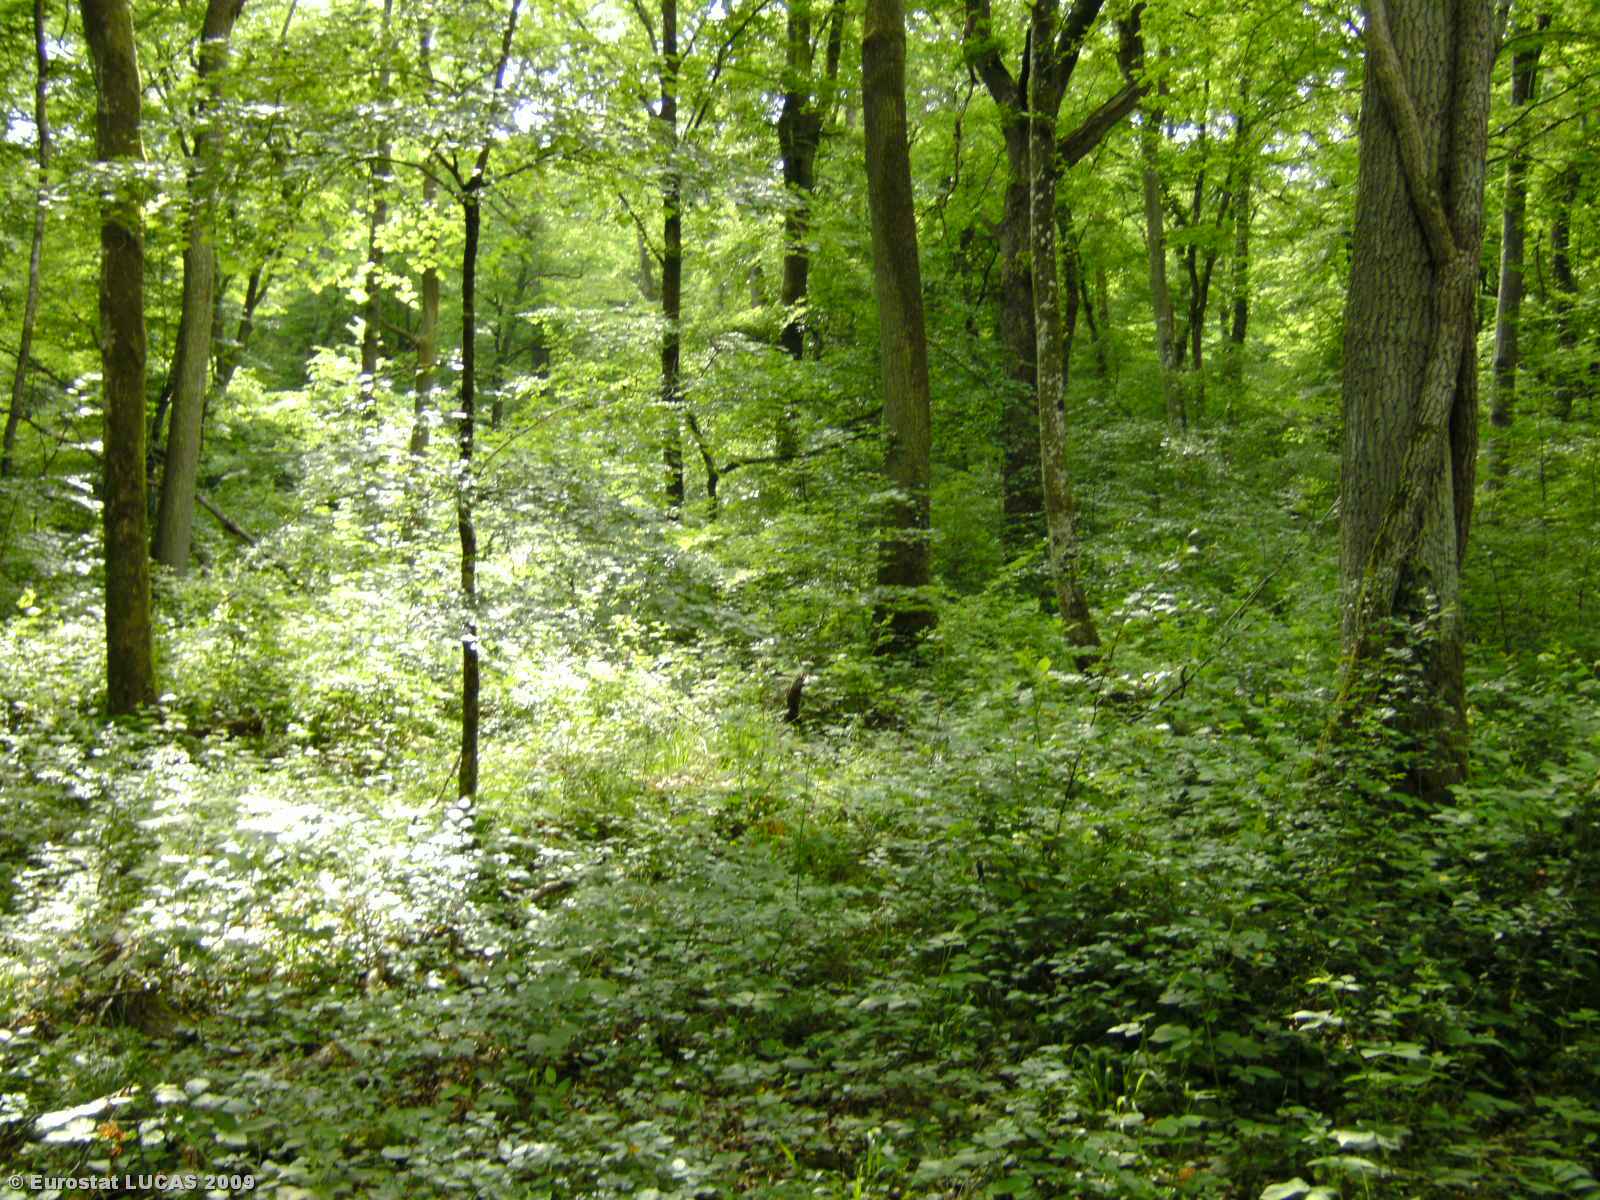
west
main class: Woodland
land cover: Broadleaved woodland
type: mesophytic deciduous forest
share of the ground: > 75 %
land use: Forestry
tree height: > 5 m
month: May
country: LU
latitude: 49.8510
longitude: 6.2025
